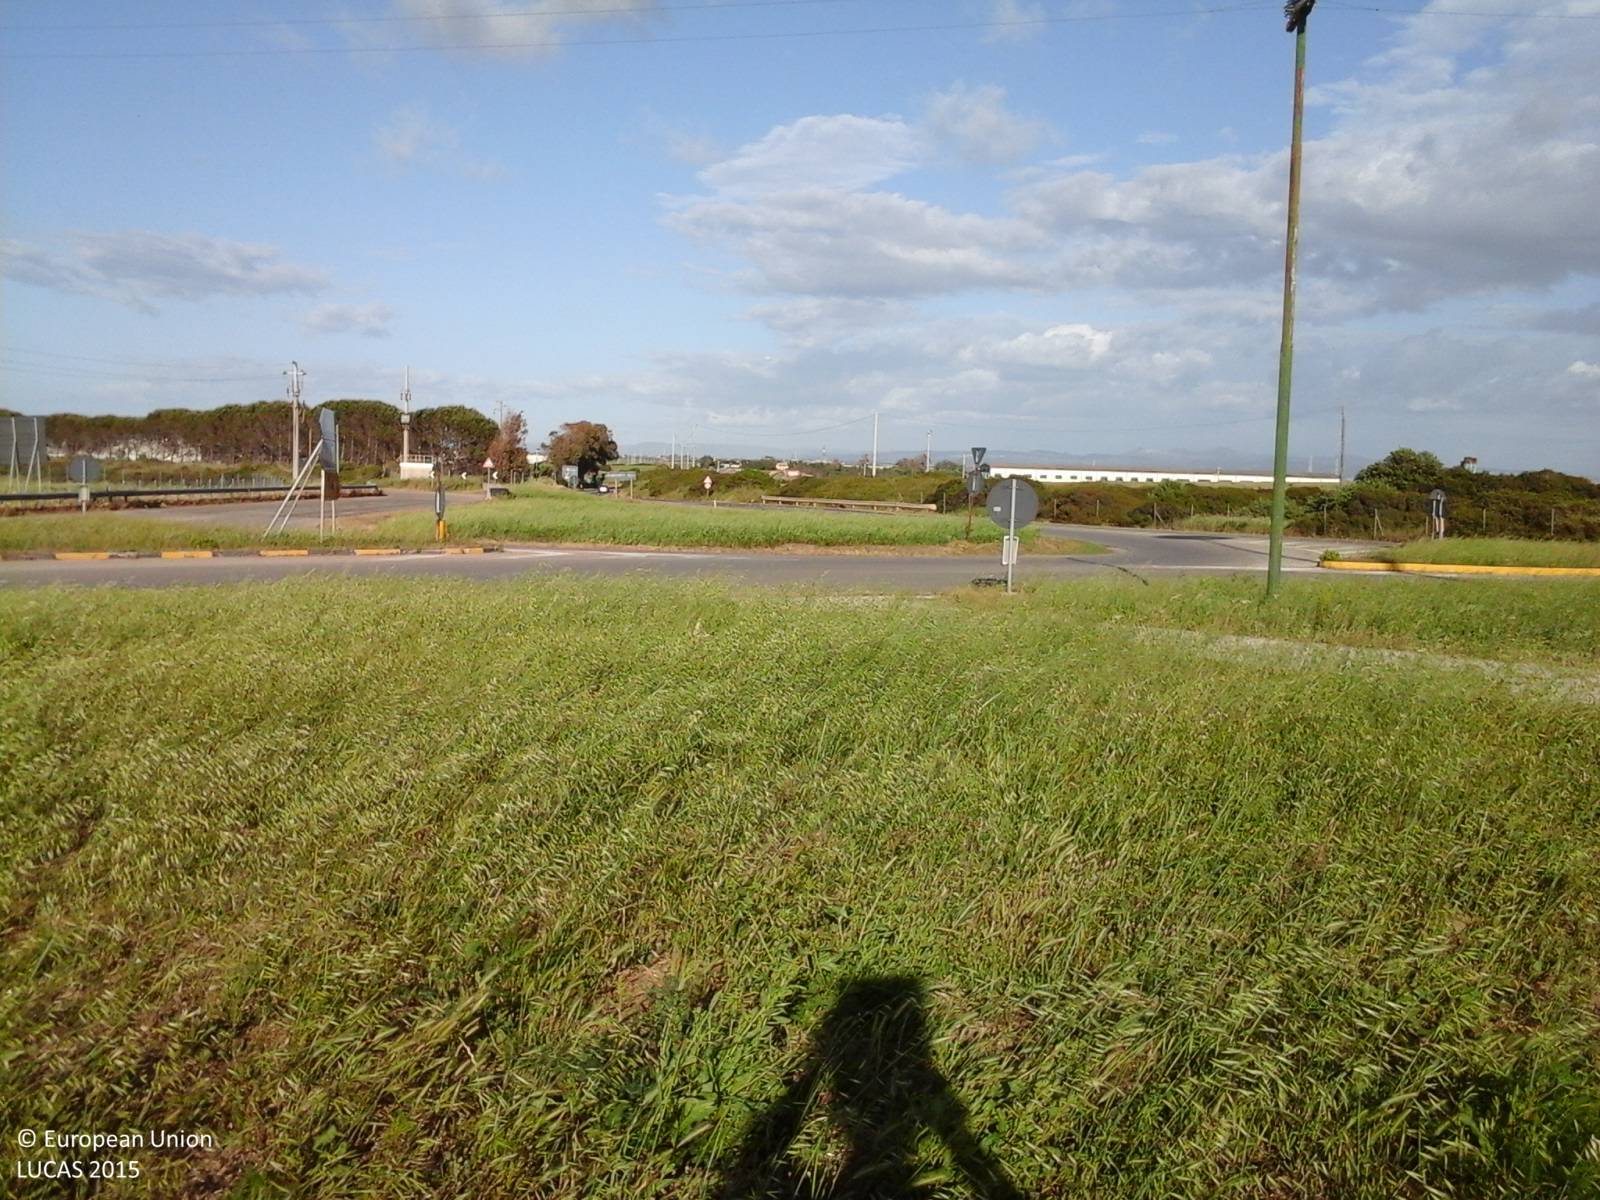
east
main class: Grassland
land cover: Grassland without tree/shrub cover
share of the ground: > 75 %
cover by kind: herbaceous plants 100 %
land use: Road transport
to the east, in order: Grassland without tree/shrub cover; Paved roads, cycling and walking lanes; Grassland without tree/shrub cover; Paved roads, cycling and walking lanes; Electric lines; Grass margins; Ditches and canals; Shrubland without tree cover
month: May
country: IT
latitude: 40.8147
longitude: 8.3598
